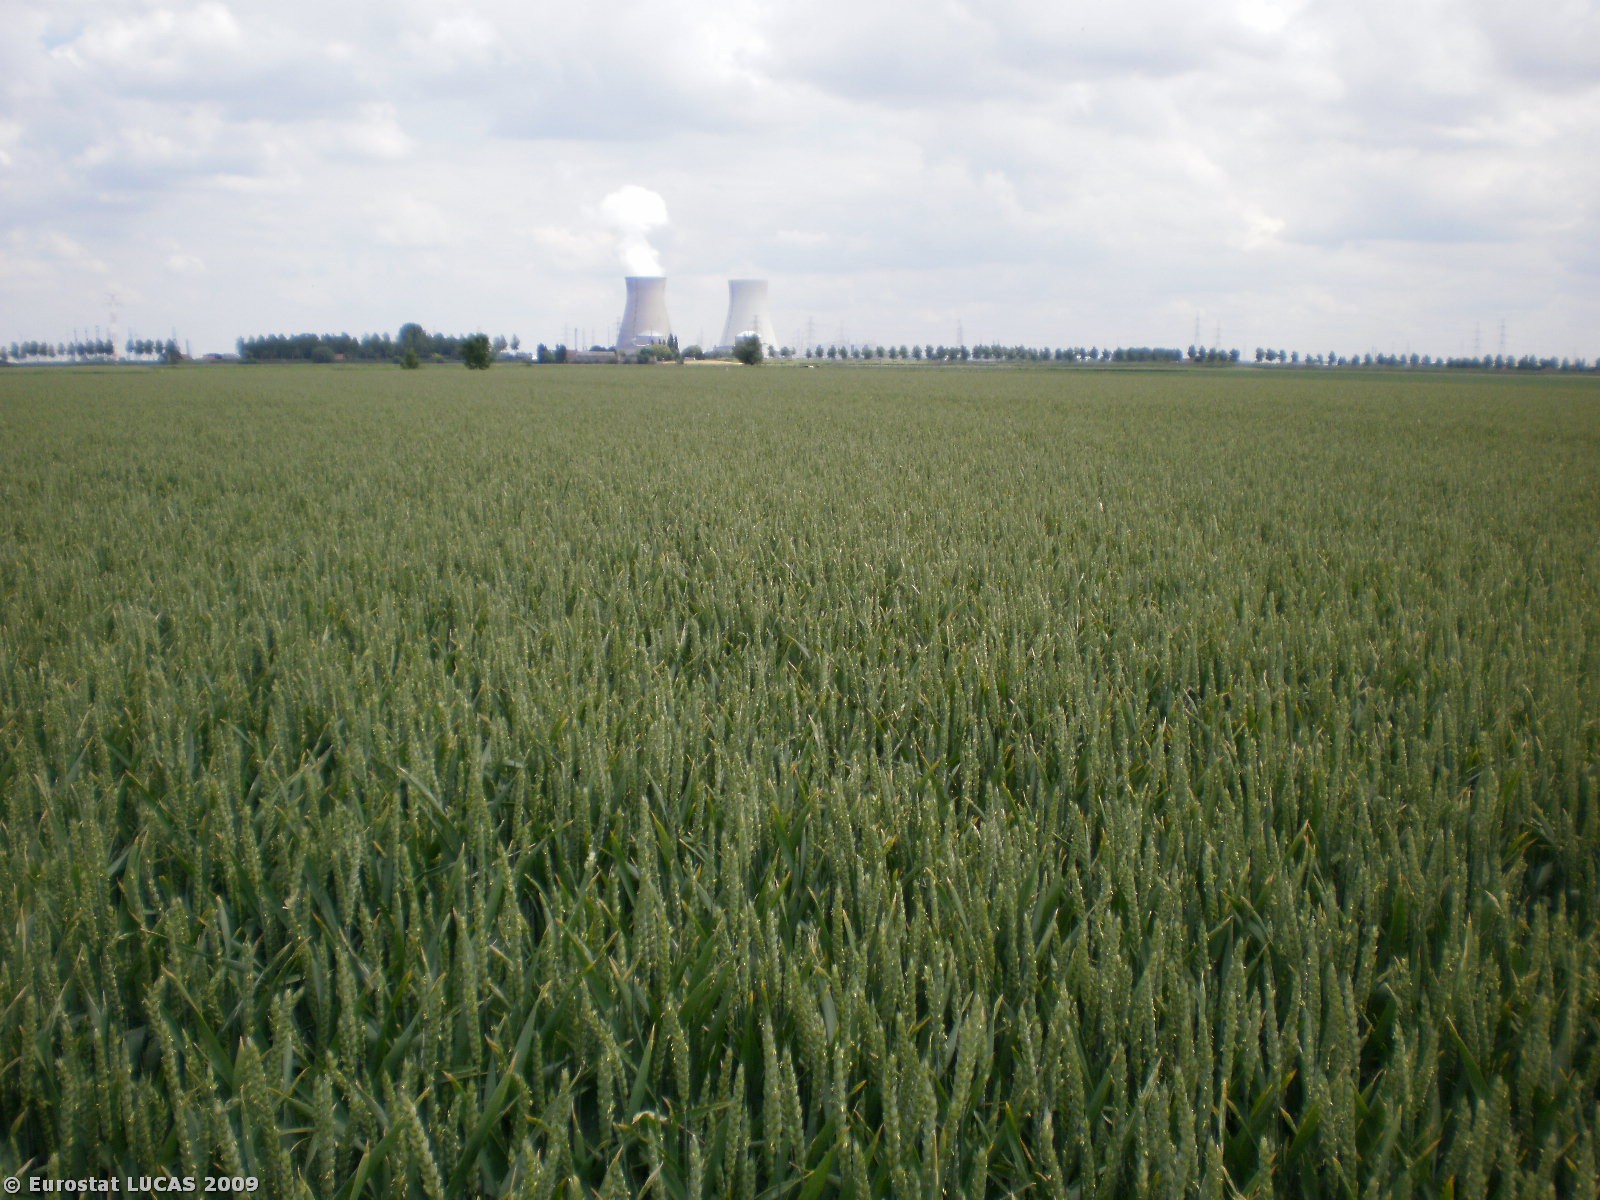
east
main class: Cropland
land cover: Common wheat
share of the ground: > 75 %
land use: Agriculture (excluding fallow land and kitchen gardens)
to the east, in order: Common wheat; Temporary grasslands
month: June
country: BE
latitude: 51.3172
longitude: 4.2126
